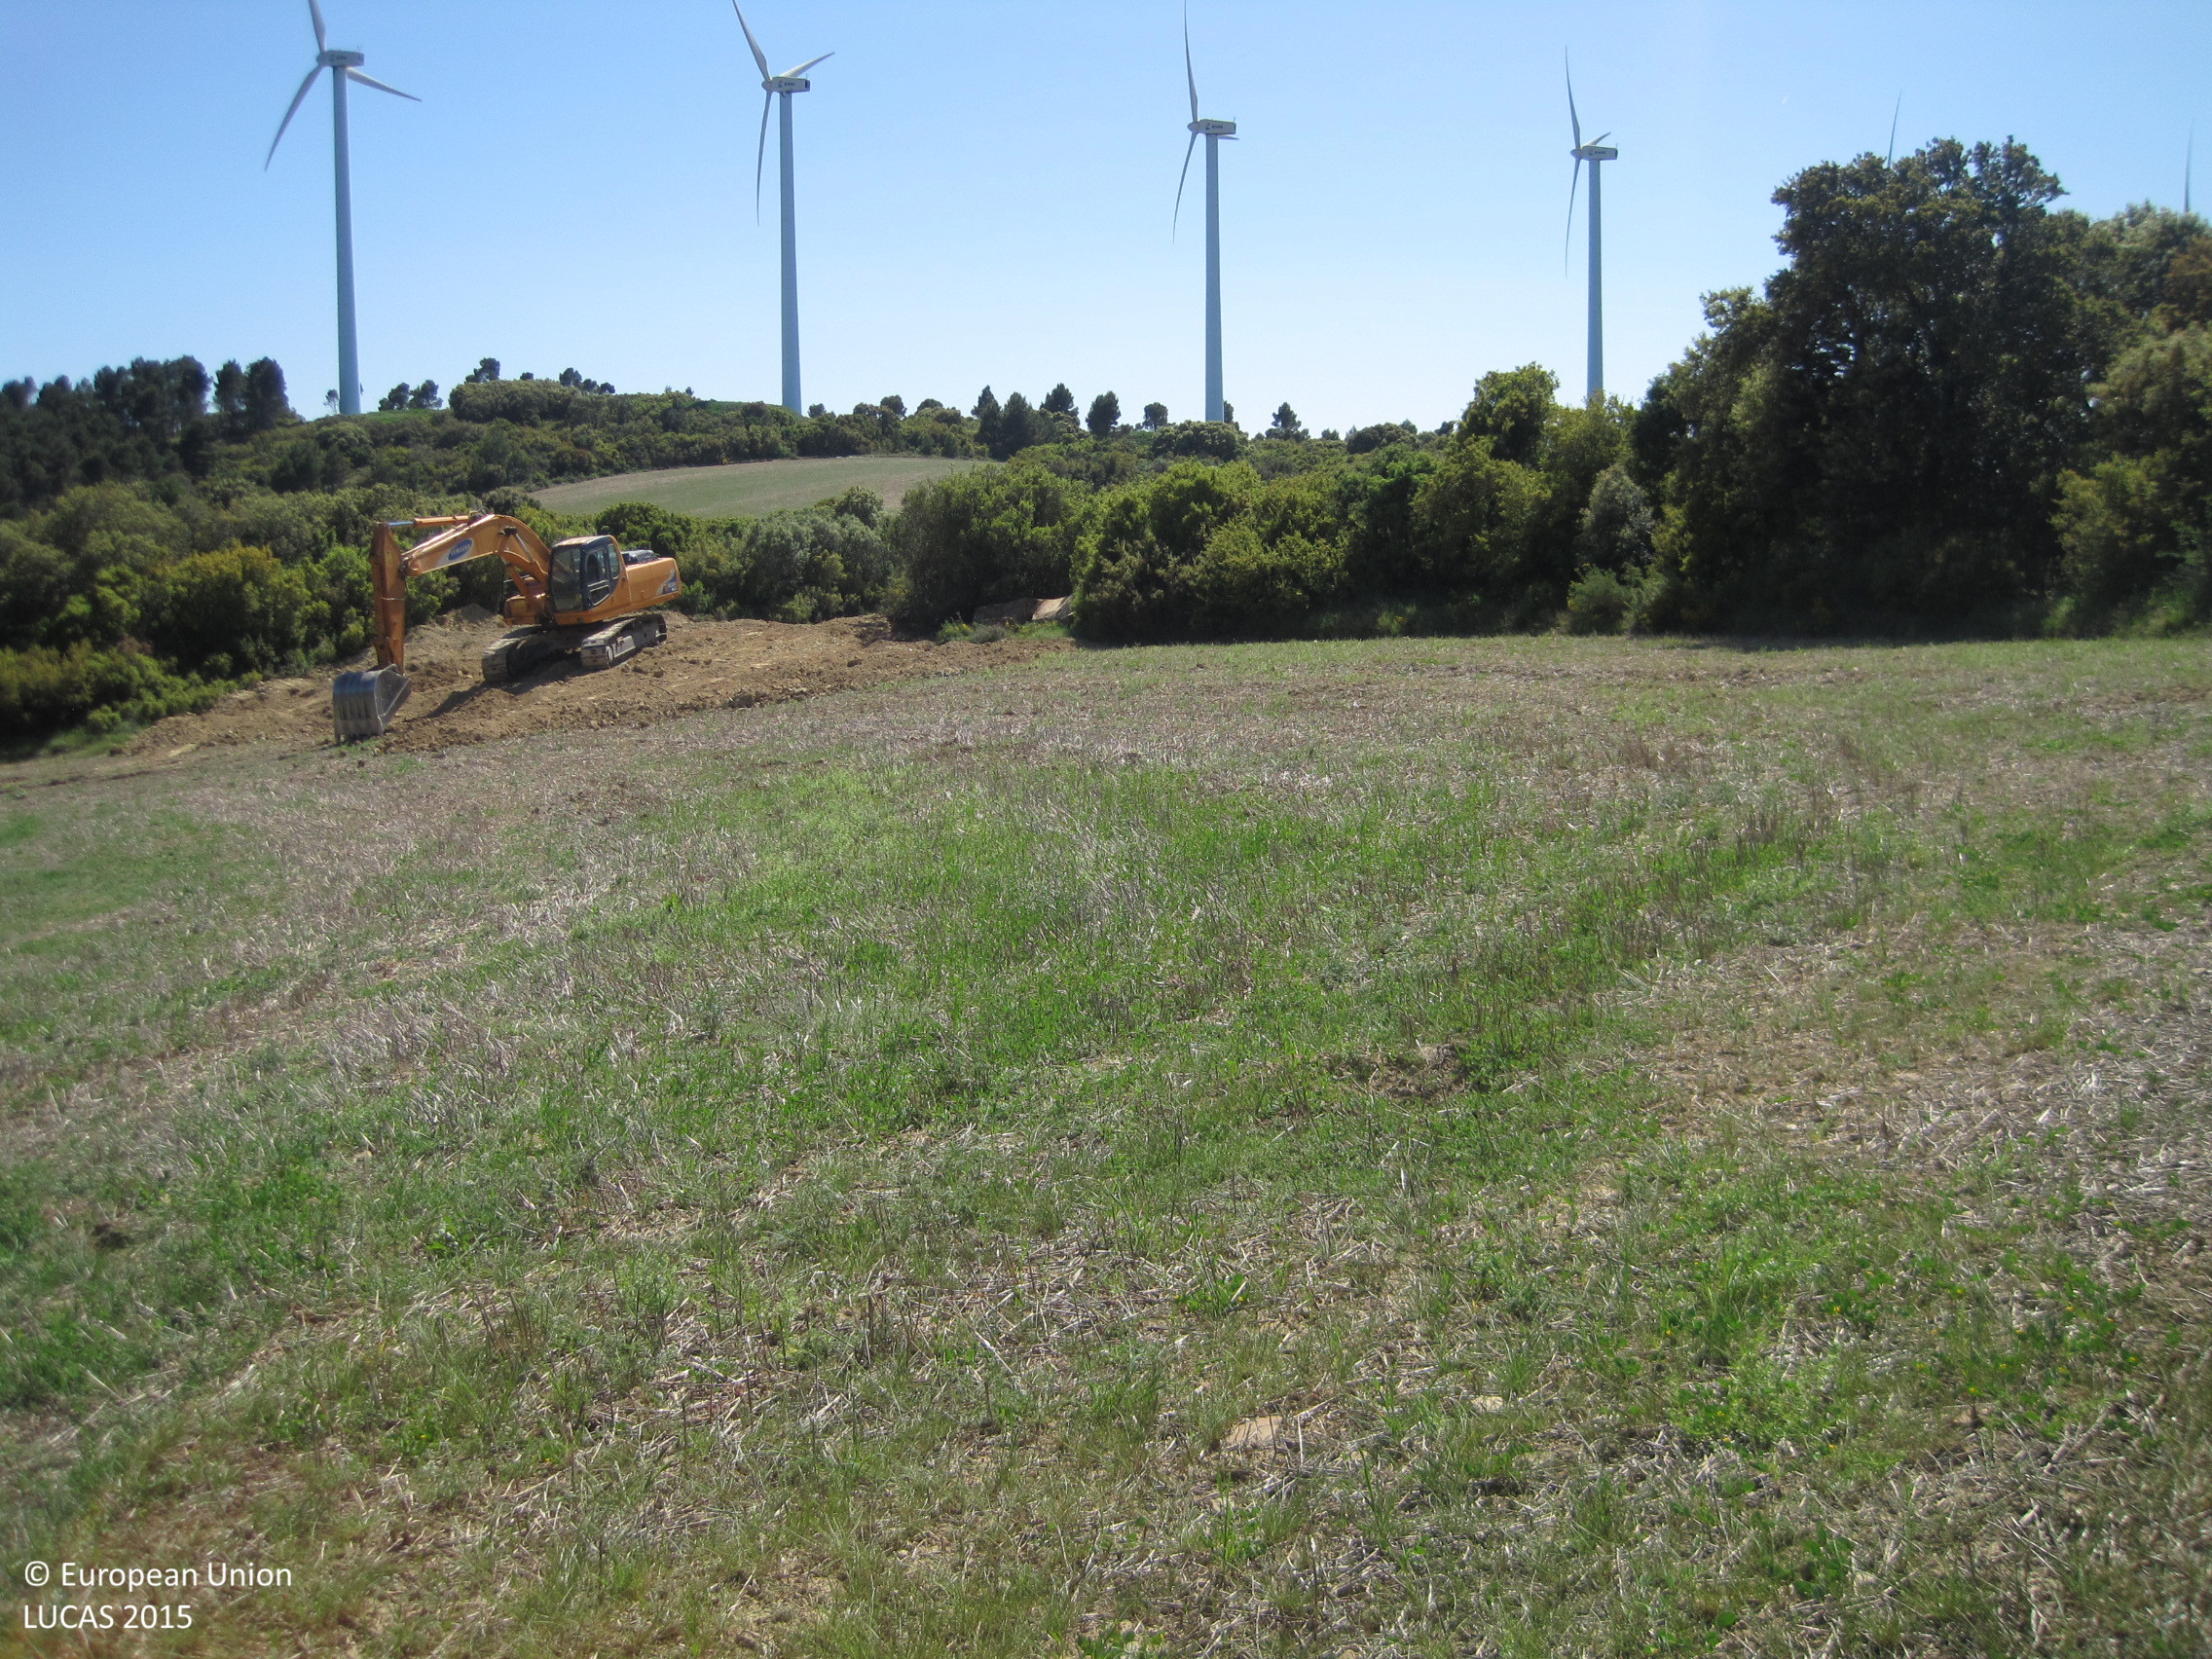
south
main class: Grassland
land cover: Spontaneously vegetated surfaces
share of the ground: > 75 %
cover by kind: herbaceous plants 60 %, unconsolidated bare surface 40 %
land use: Fallow land
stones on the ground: < 10 %
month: May
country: ES
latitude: 42.5303
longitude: -1.6141
